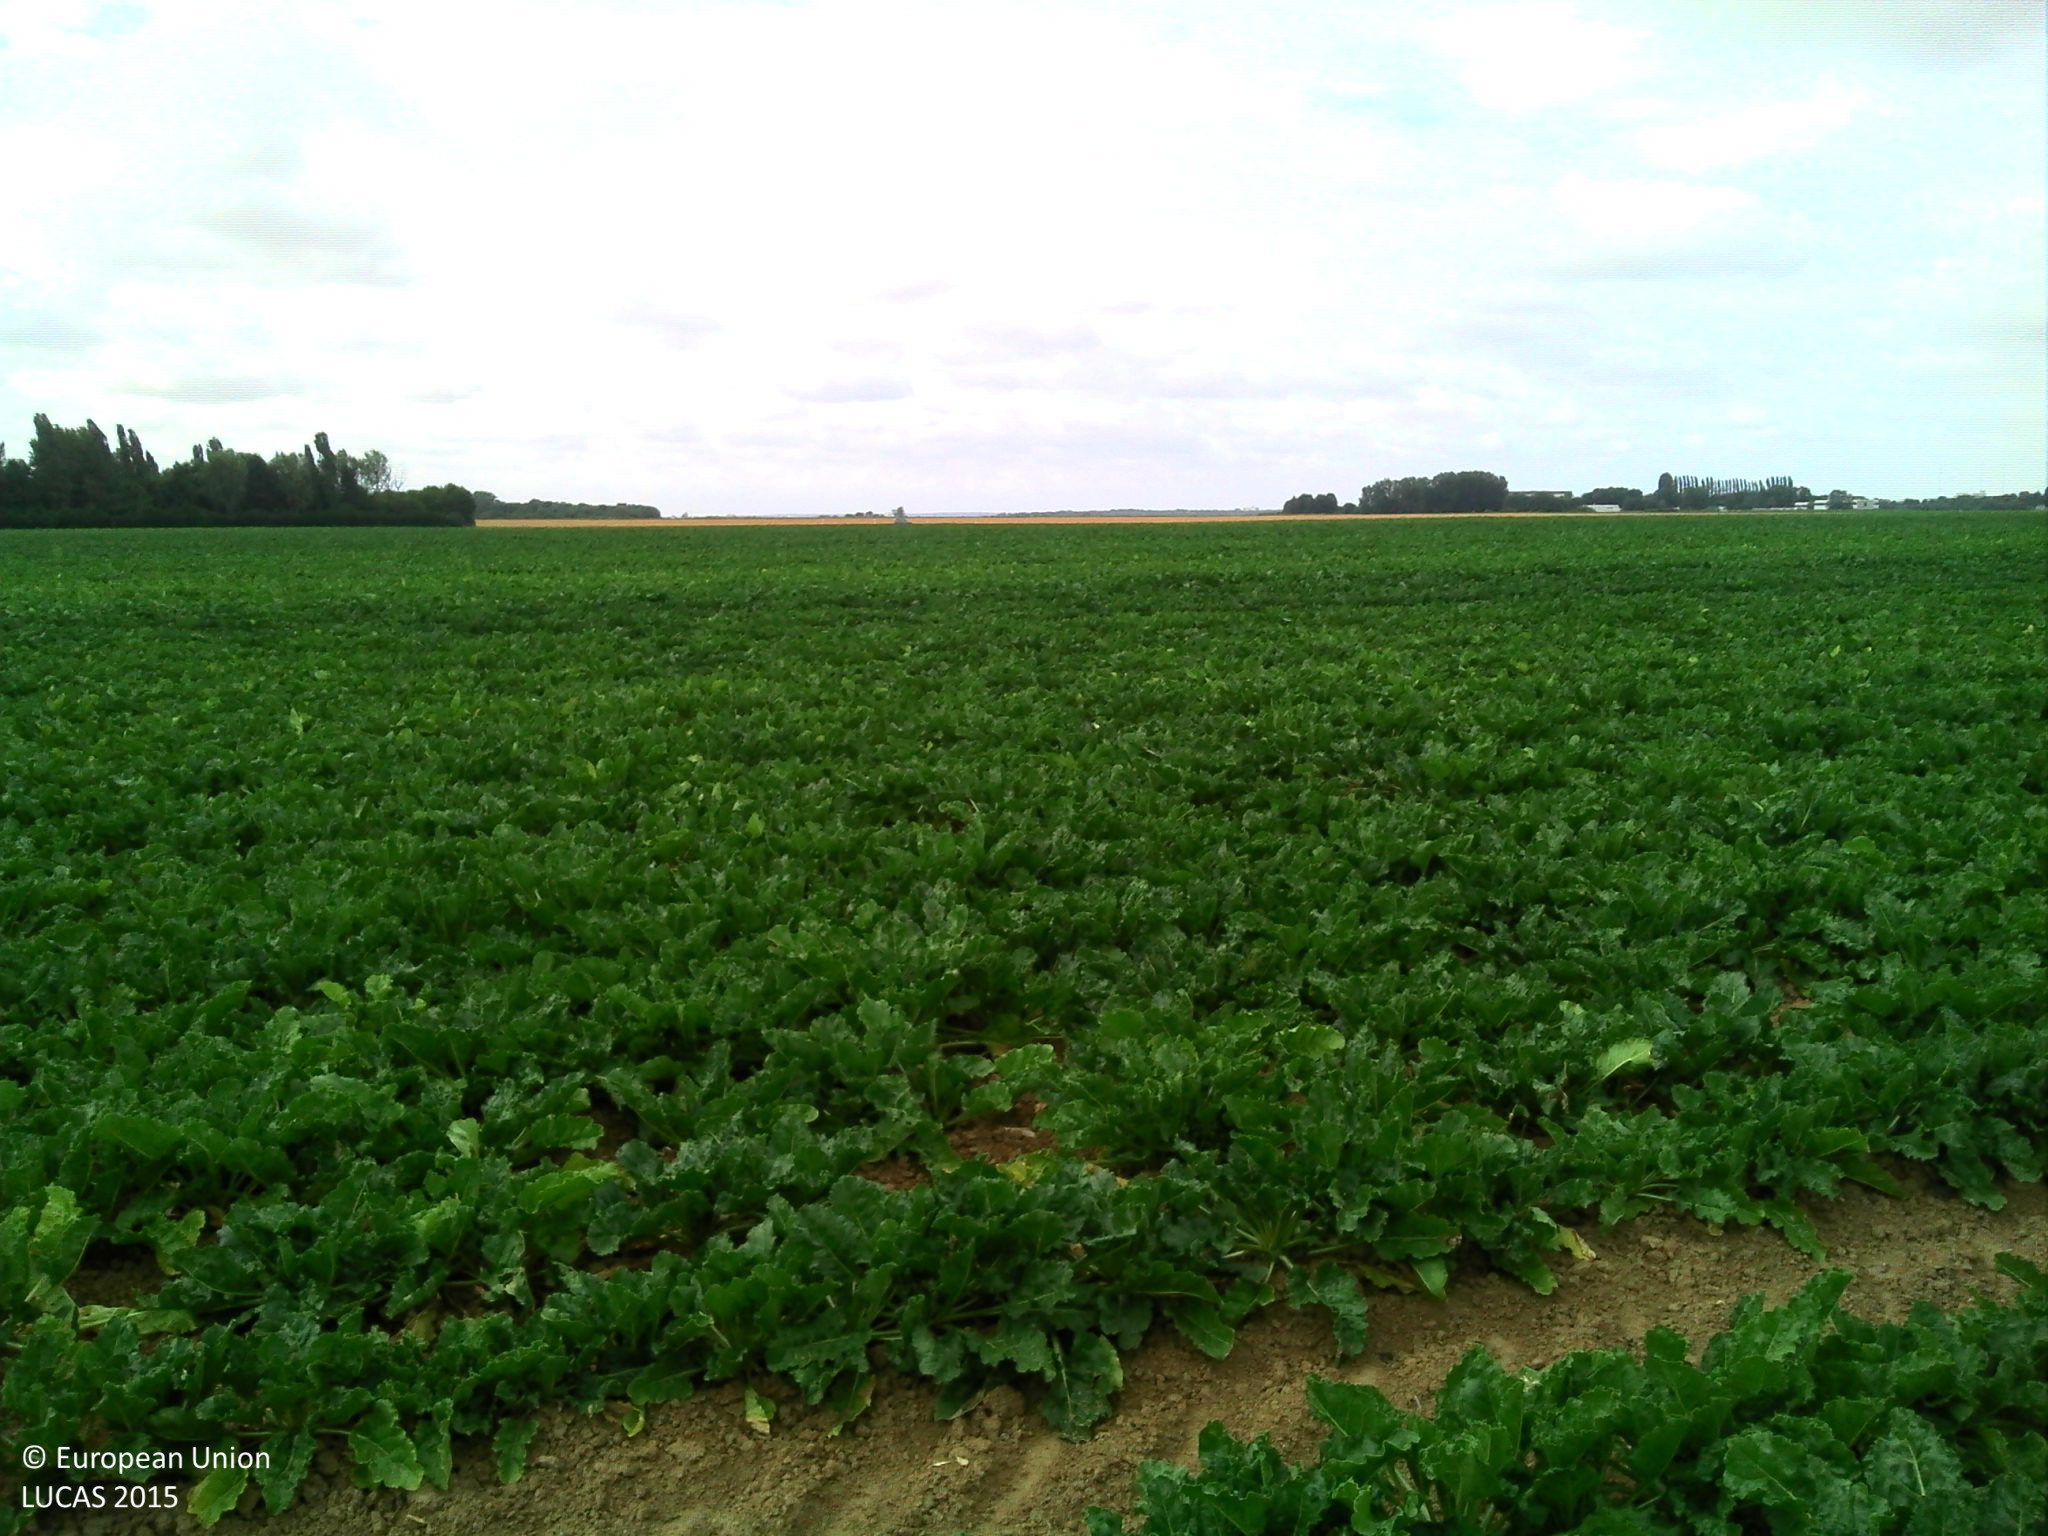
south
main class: Cropland
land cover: Sugar beet
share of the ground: > 75 %
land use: Agriculture (excluding fallow land and kitchen gardens)
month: July
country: FR
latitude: 48.6302
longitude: 2.6766
